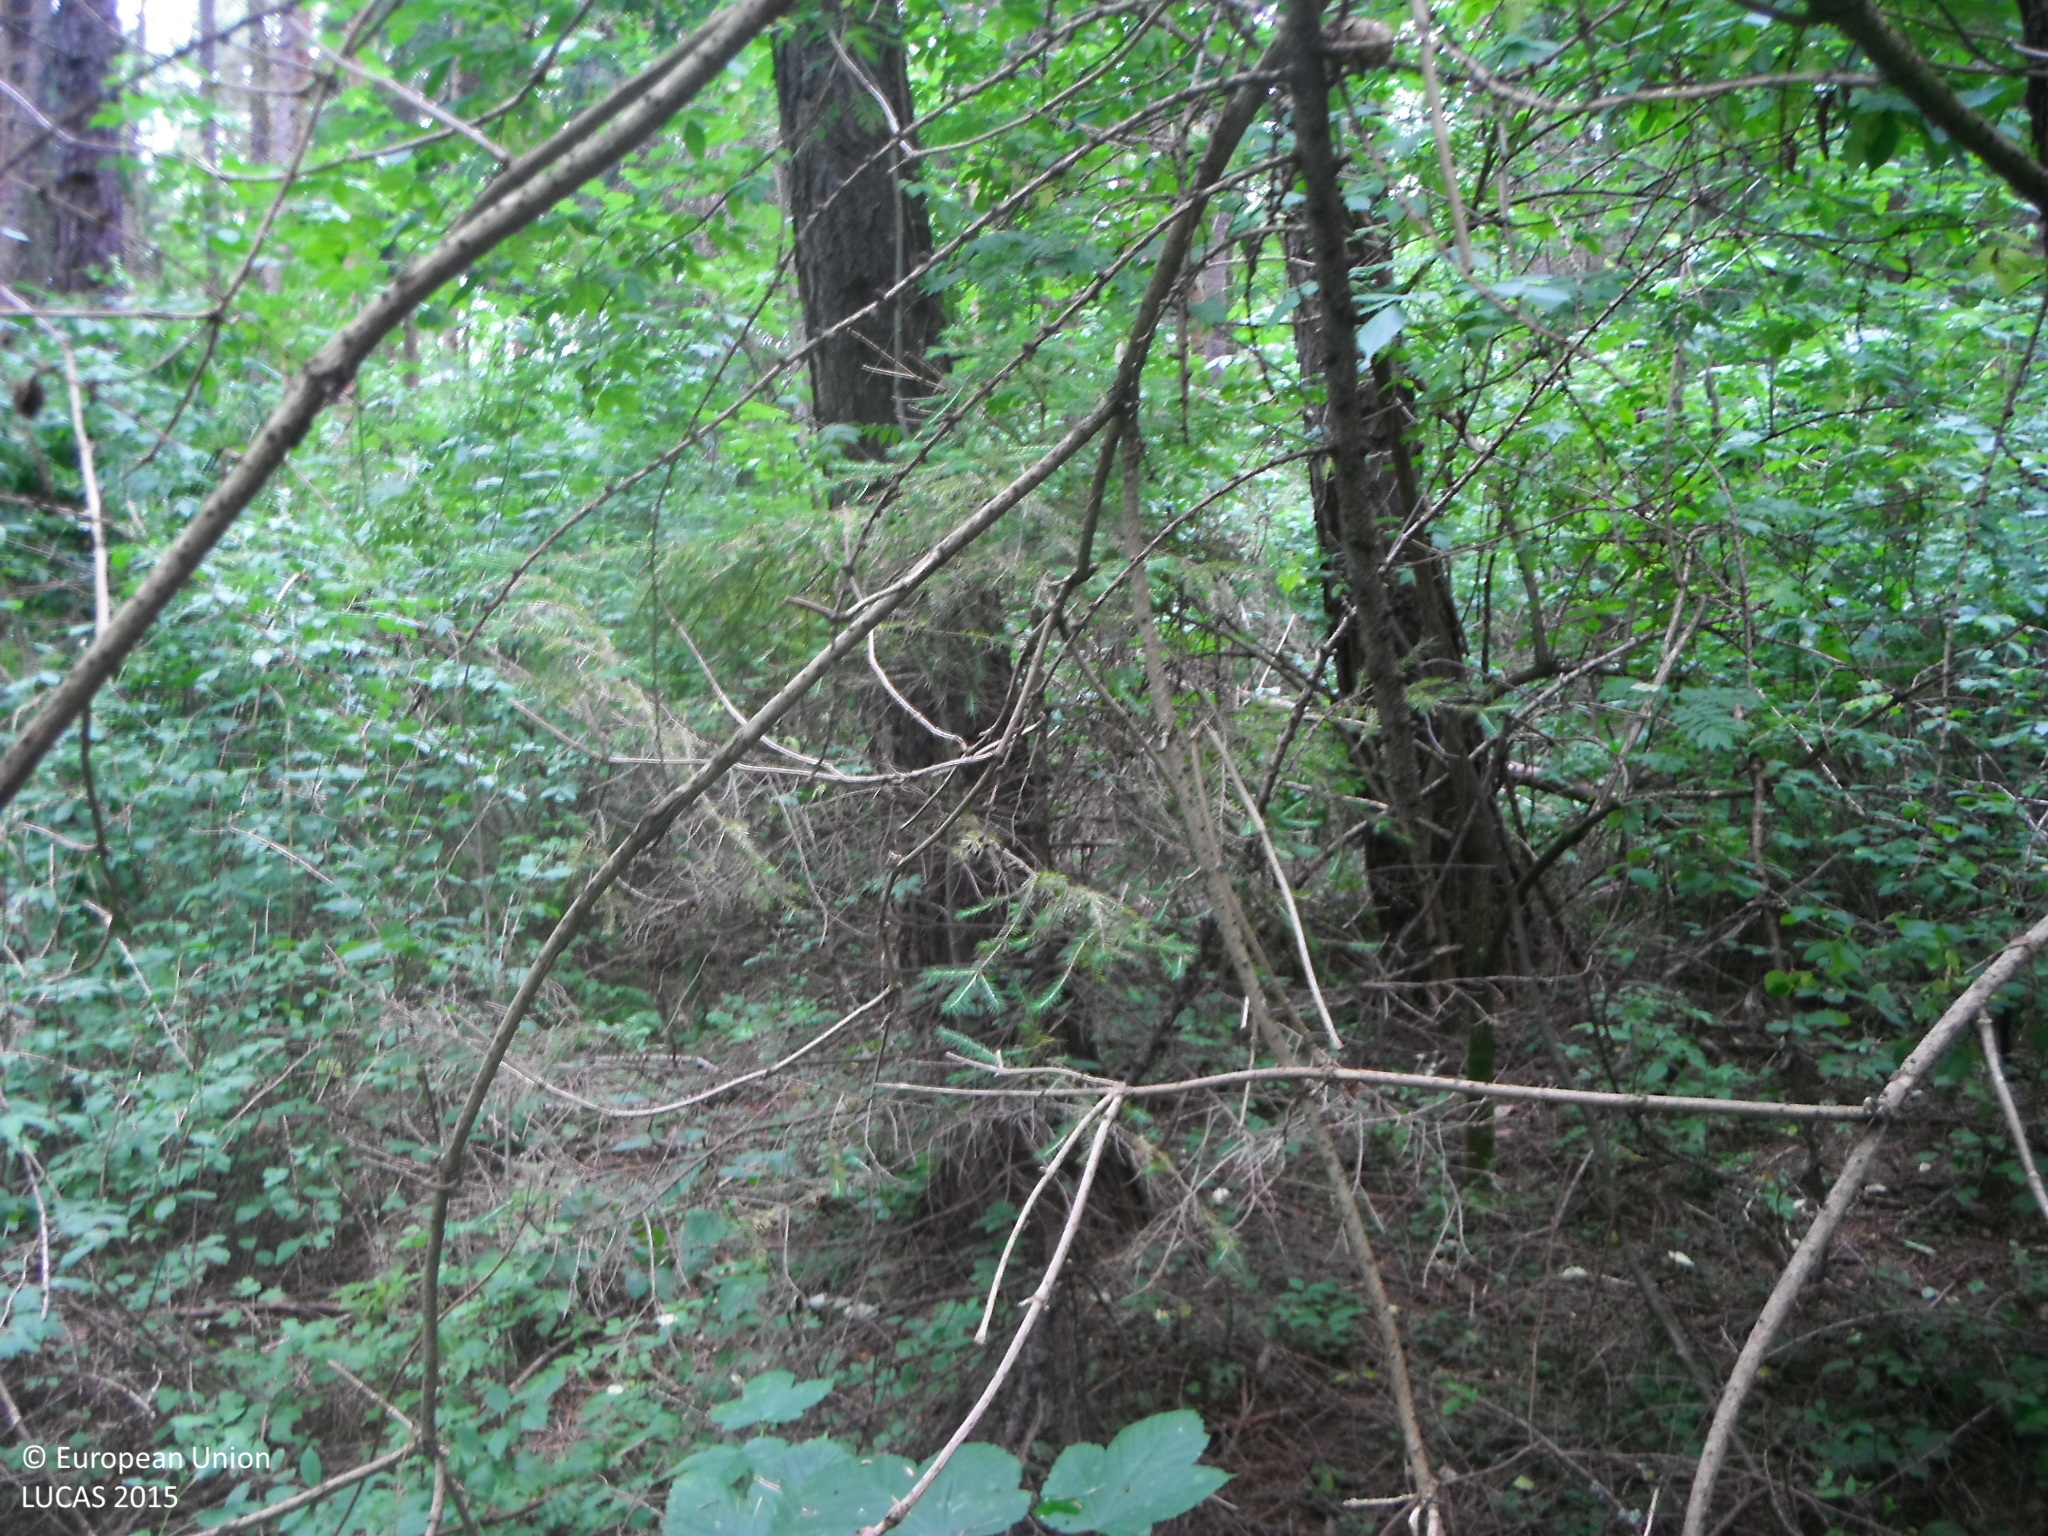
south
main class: Woodland
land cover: Other mixed woodland
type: hemiboreal forest and nemoral coniferous forest and mixed broadleaved-coniferous forest
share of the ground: > 75 %
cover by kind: coniferous forest trees 65 %, broadleaved forest trees 35 %
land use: Amenities, museums, leisure
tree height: > 5 m
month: July
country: SK
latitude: 49.0270
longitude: 20.3048
